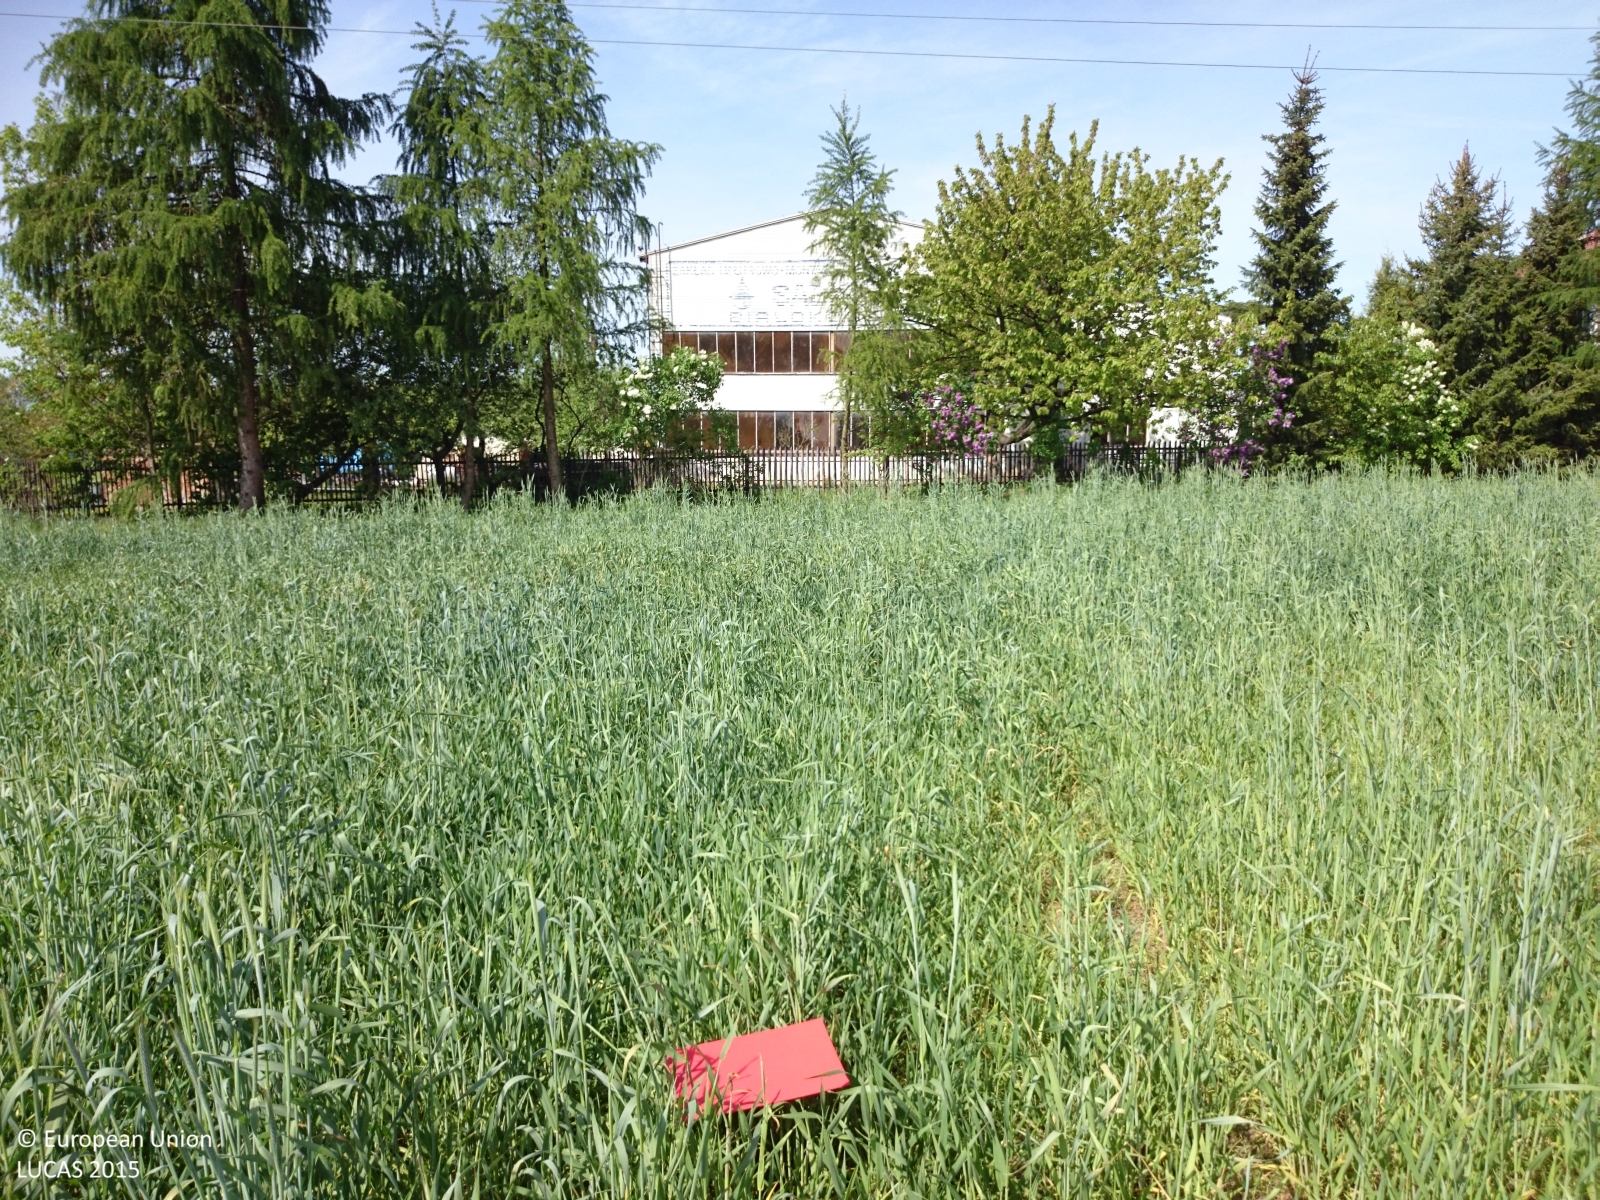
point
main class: Cropland
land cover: Rye
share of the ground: > 75 %
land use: Agriculture (excluding fallow land and kitchen gardens)
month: May
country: PL
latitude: 52.5556
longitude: 16.2454
